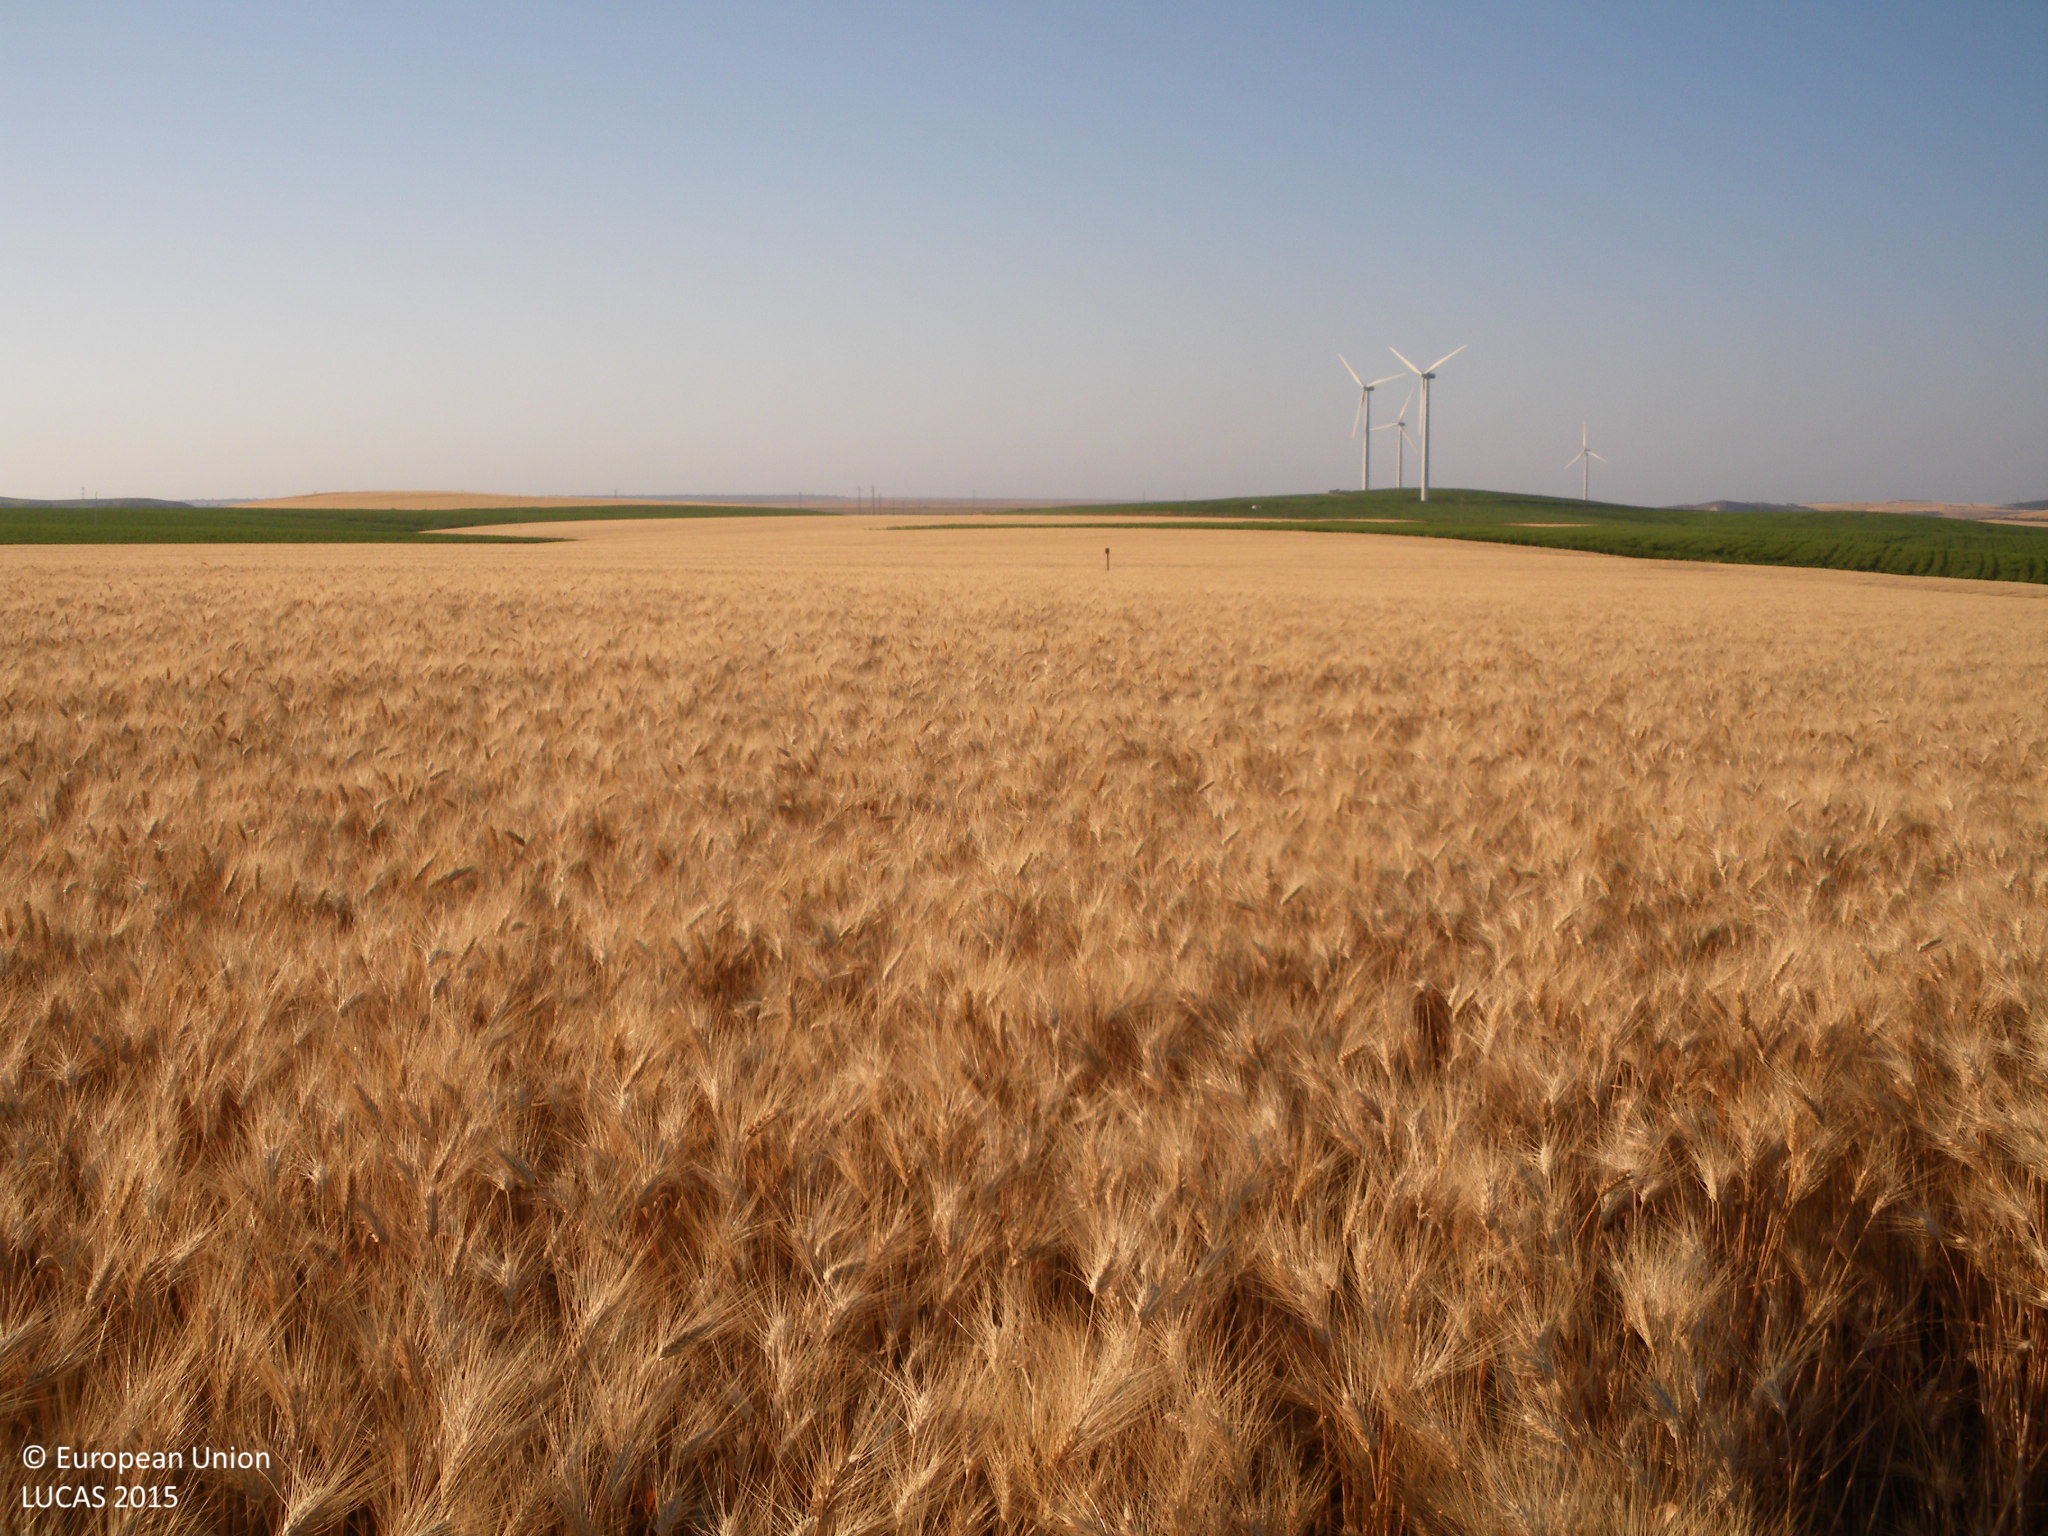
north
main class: Cropland
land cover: Durum wheat
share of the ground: > 75 %
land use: Agriculture (excluding fallow land and kitchen gardens)
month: May
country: ES
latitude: 36.7606
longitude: -6.2700
